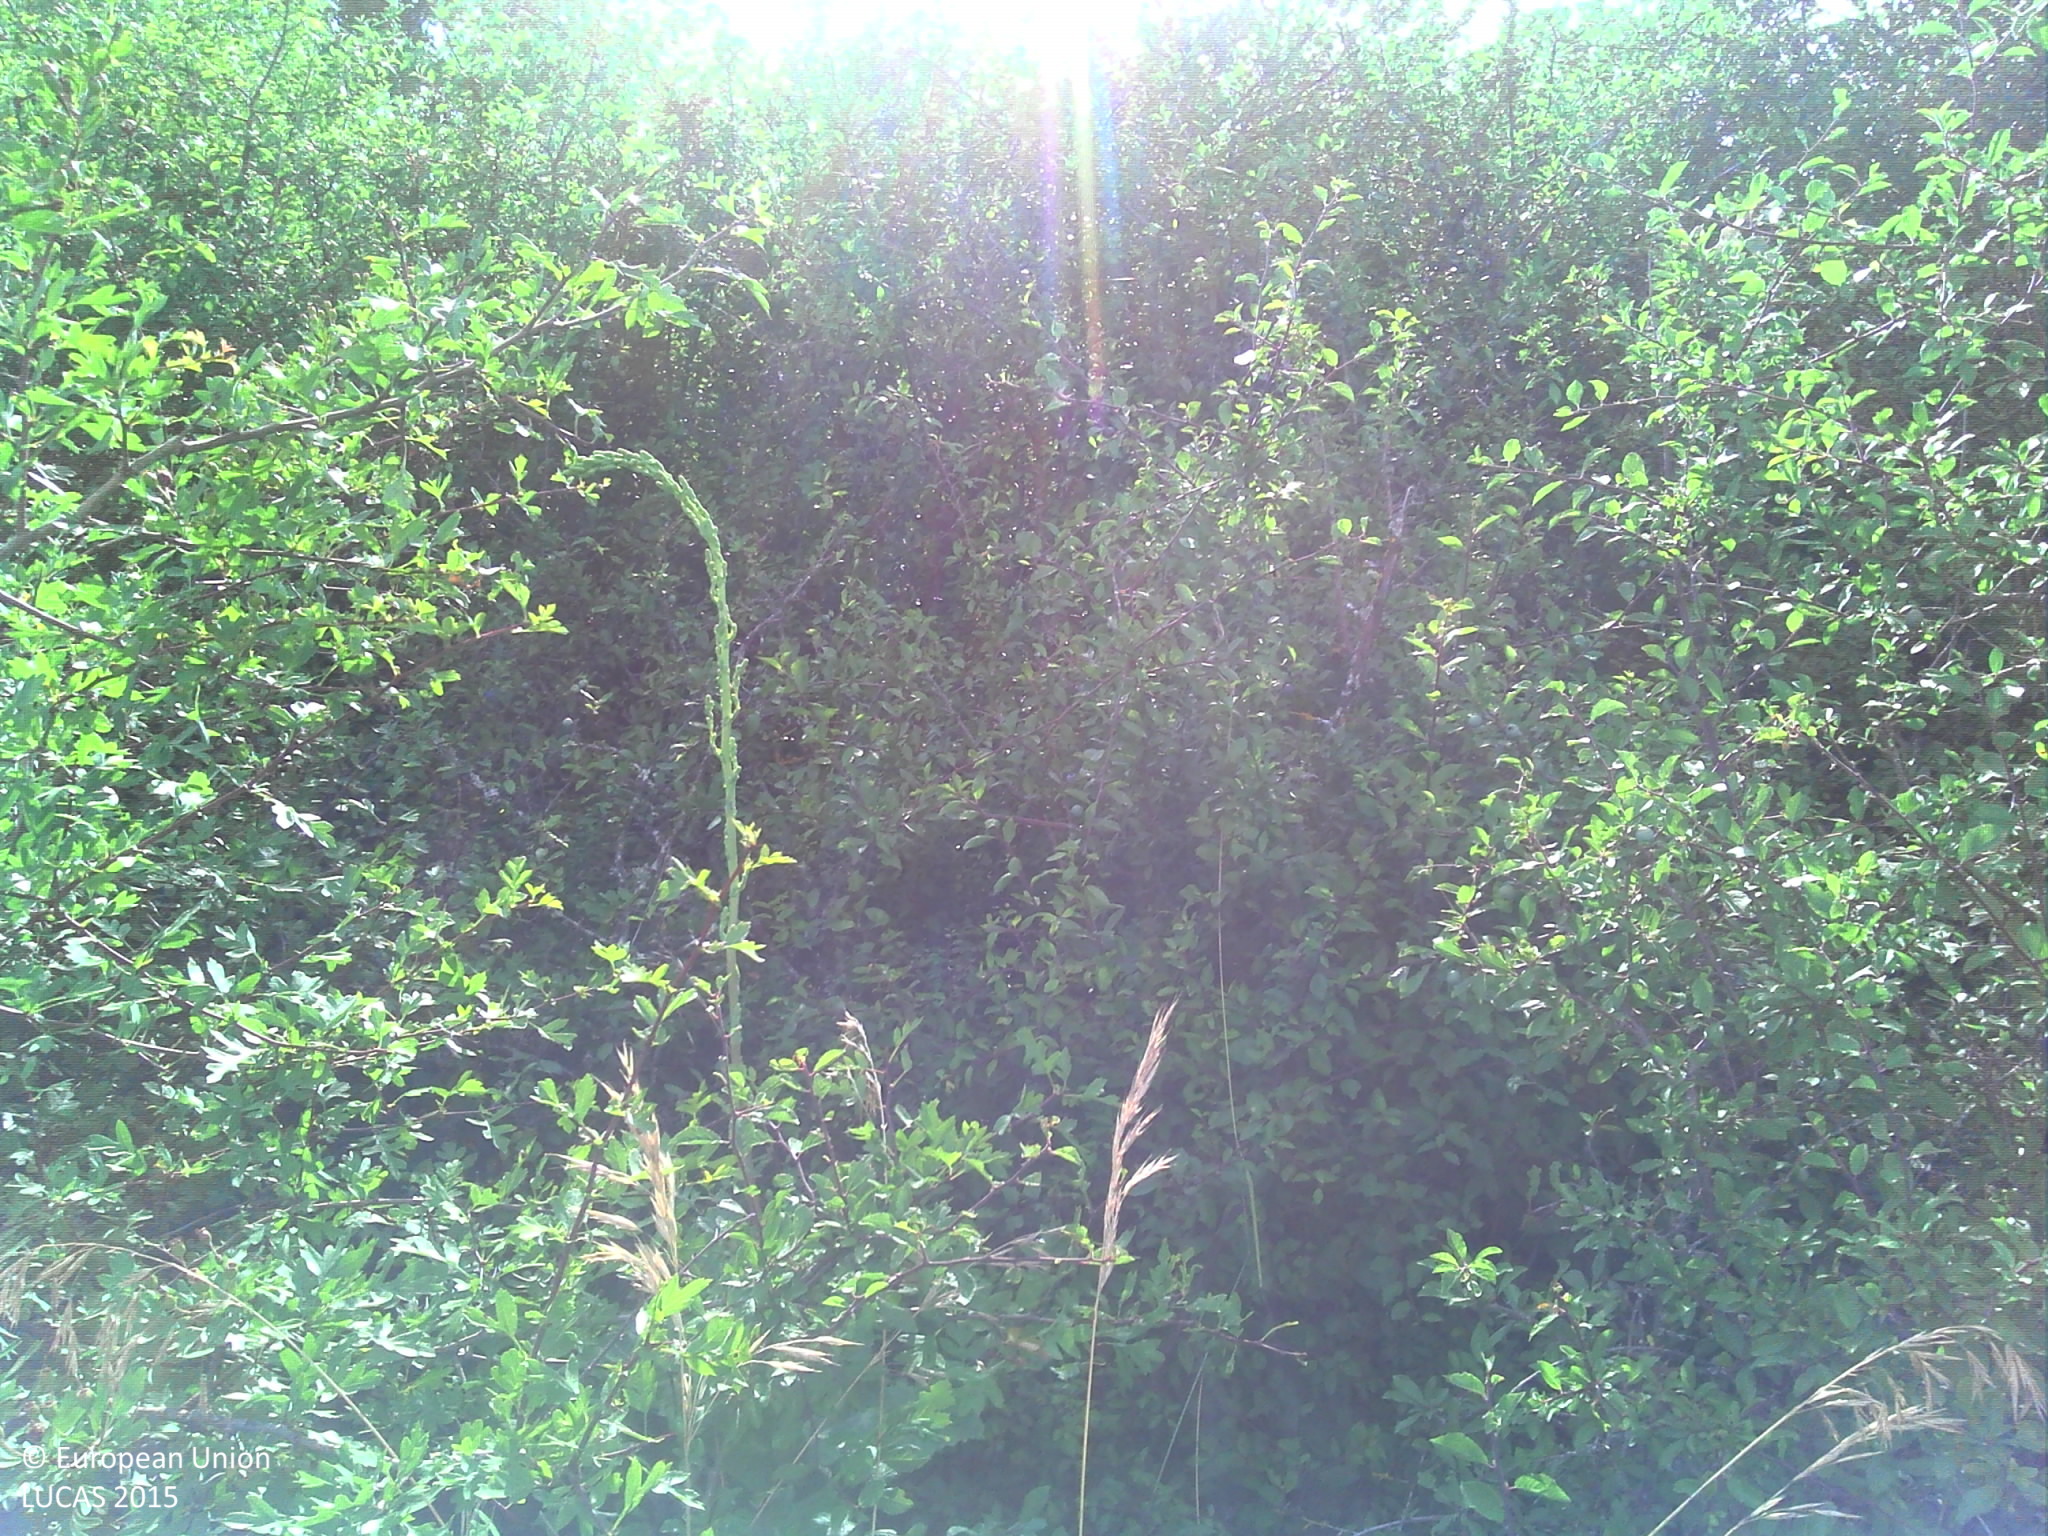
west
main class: Shrubland
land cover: Shrubland with sparse tree cover
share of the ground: > 75 %
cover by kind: shrubs 95 %, broadleaved forest trees 5 %
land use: Abandoned areas
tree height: < 5 m
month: June
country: FR
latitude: 44.0896
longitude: 1.9213
